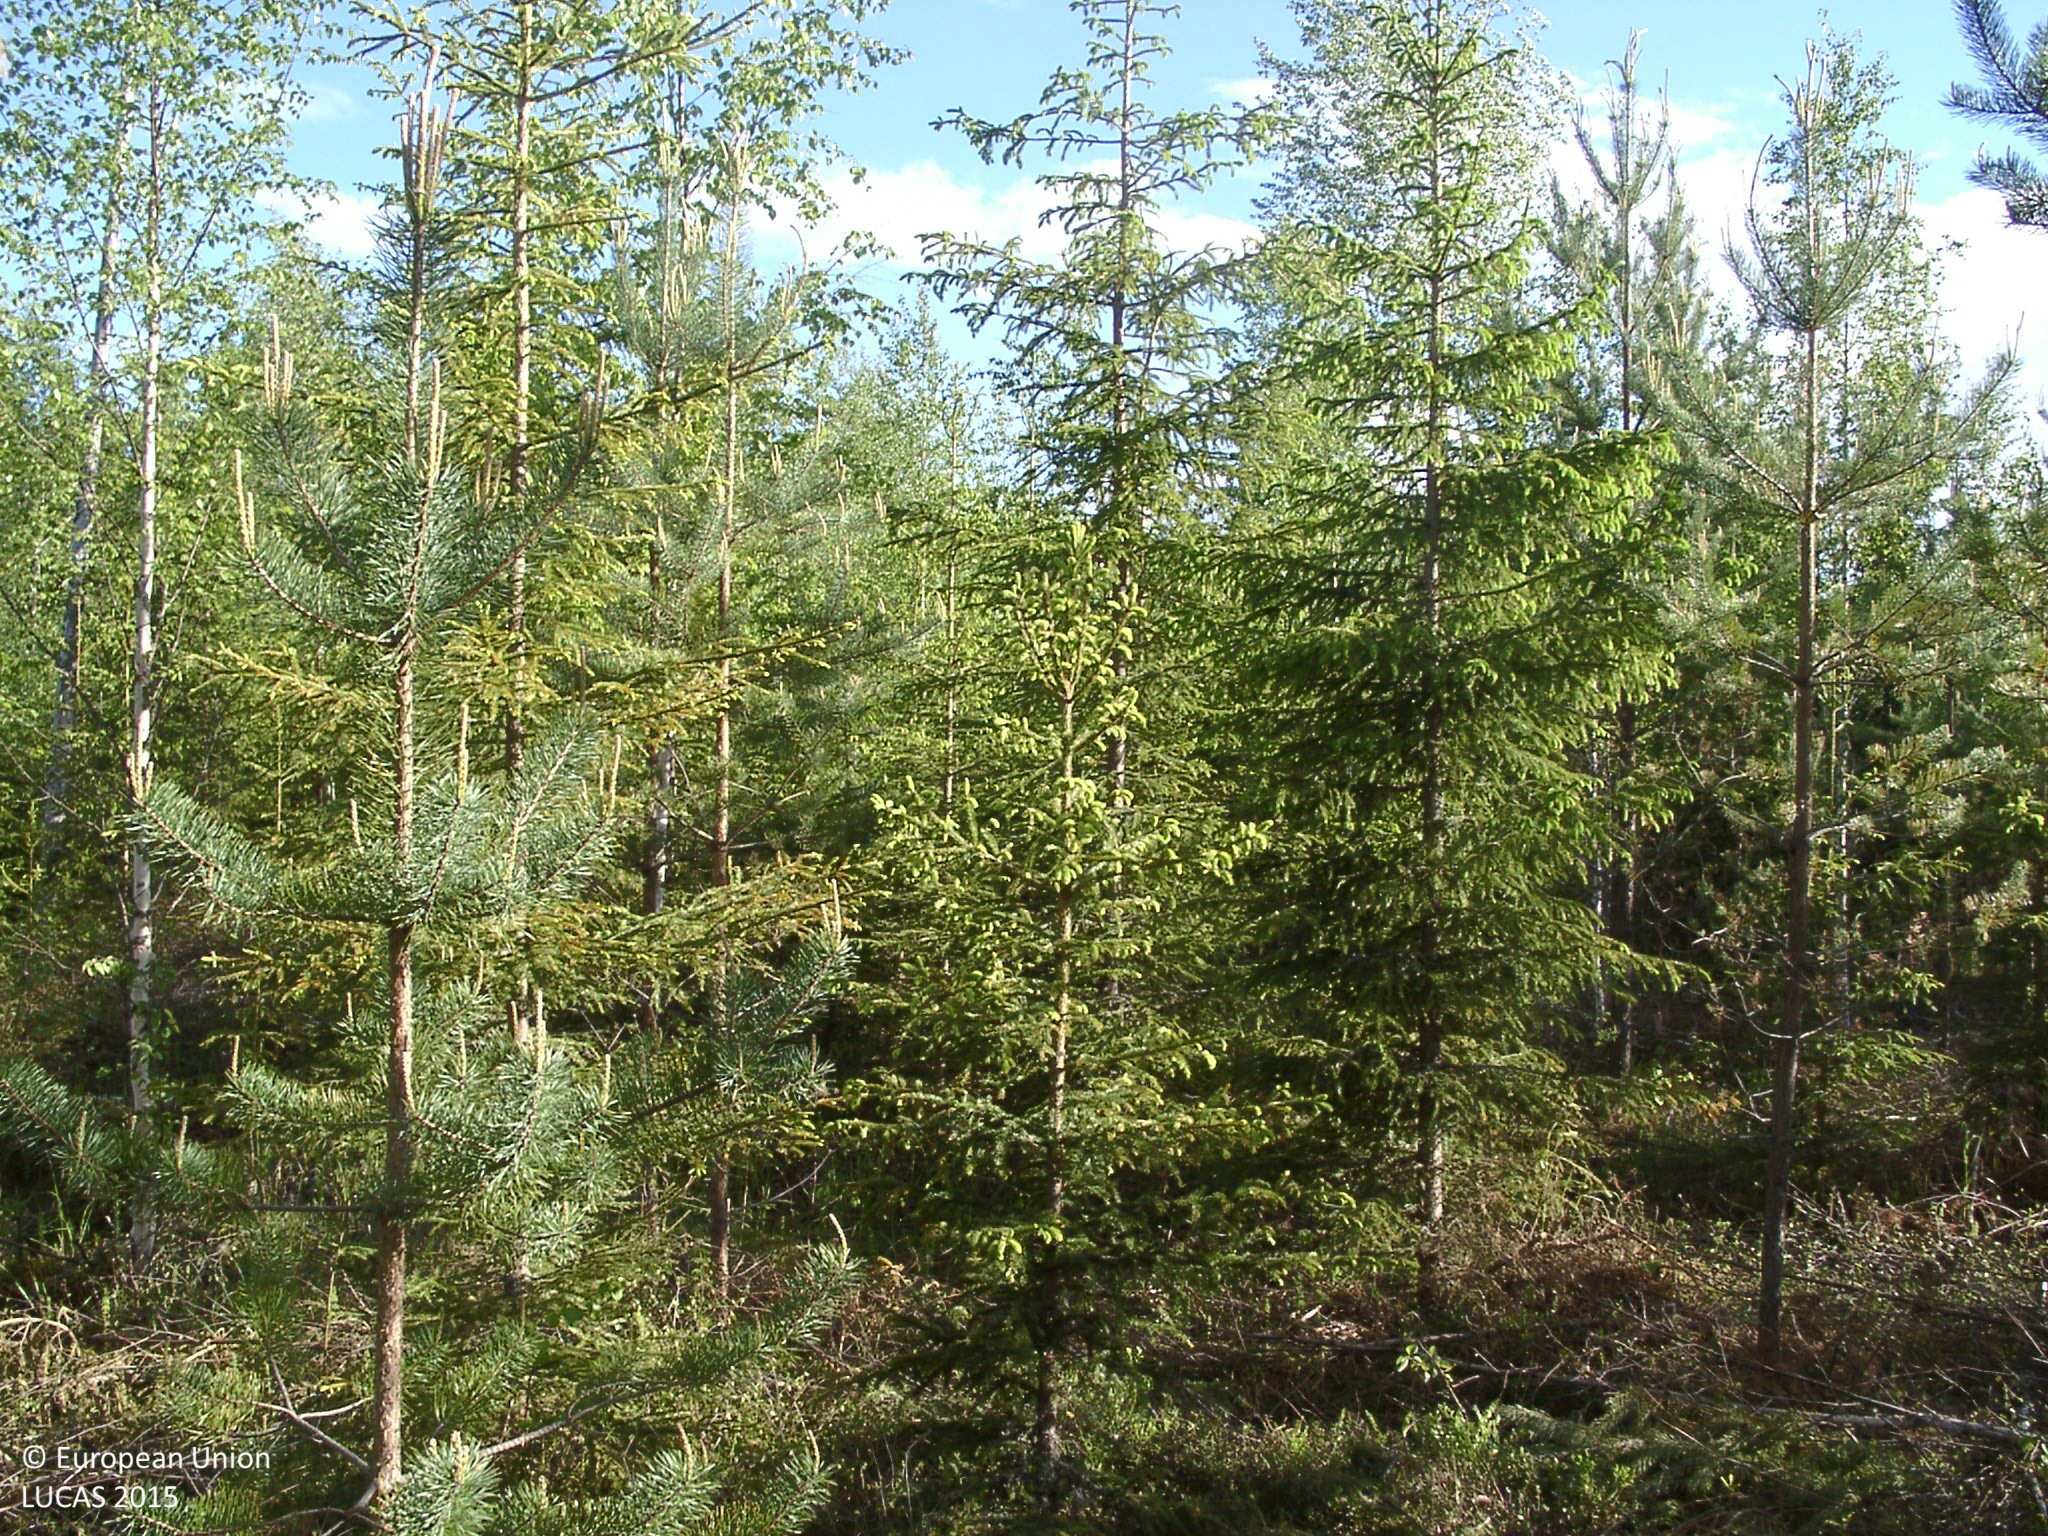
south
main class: Woodland
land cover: Other mixed woodland
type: boreal forest
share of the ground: 25 - 50 %
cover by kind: coniferous forest trees 30 %, shrubs 25 %, broadleaved forest trees 10 %, lichens and mosses 10 %, herbaceous plants 5 %
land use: Forestry
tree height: < 5 m
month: June
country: FI
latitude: 61.7371
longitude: 24.8899
